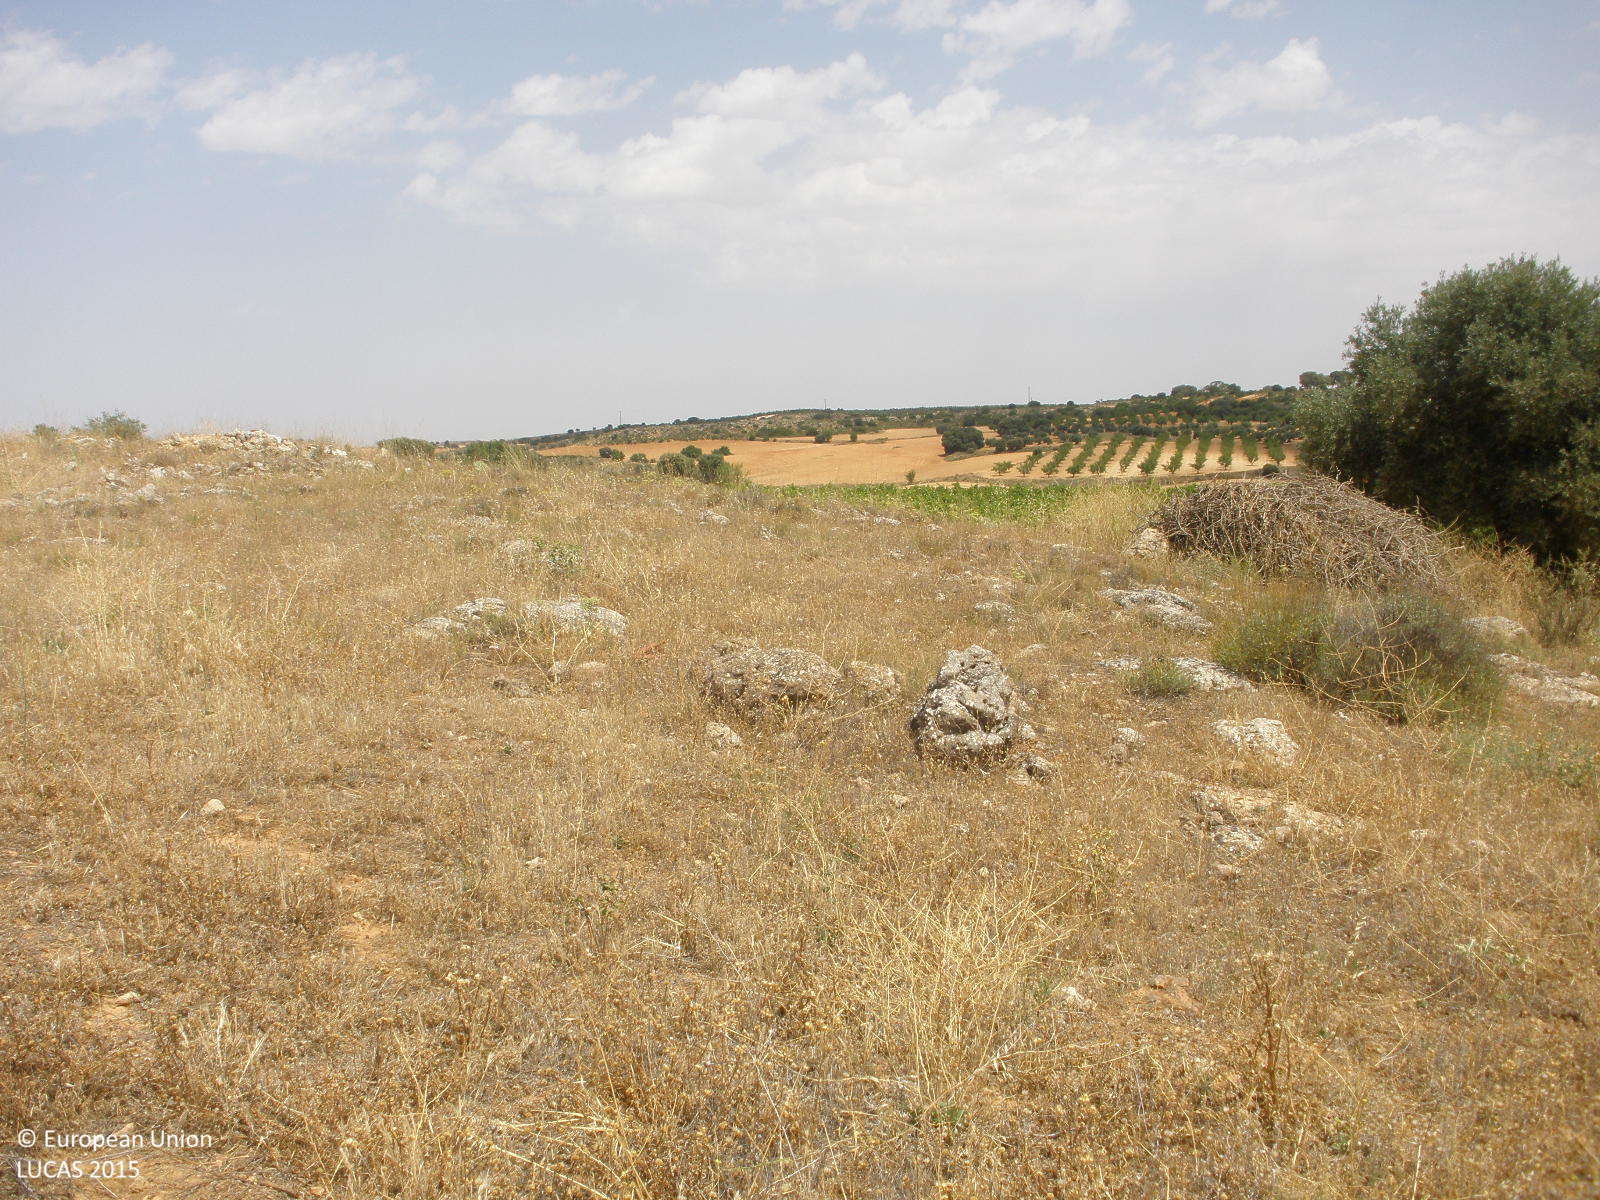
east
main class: Grassland
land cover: Grassland without tree/shrub cover
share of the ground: > 75 %
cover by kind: herbaceous plants 85 %, consolidated bare surface 10 %, shrubs 5 %
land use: Abandoned areas
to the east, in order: Grassland without tree/shrub cover; Rock outcrops; Grassland without tree/shrub cover; Vineyards; Tracks; Grass margins; Olive groves; Shrubland without tree cover
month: July
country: ES
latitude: 39.8676
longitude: -3.3179
